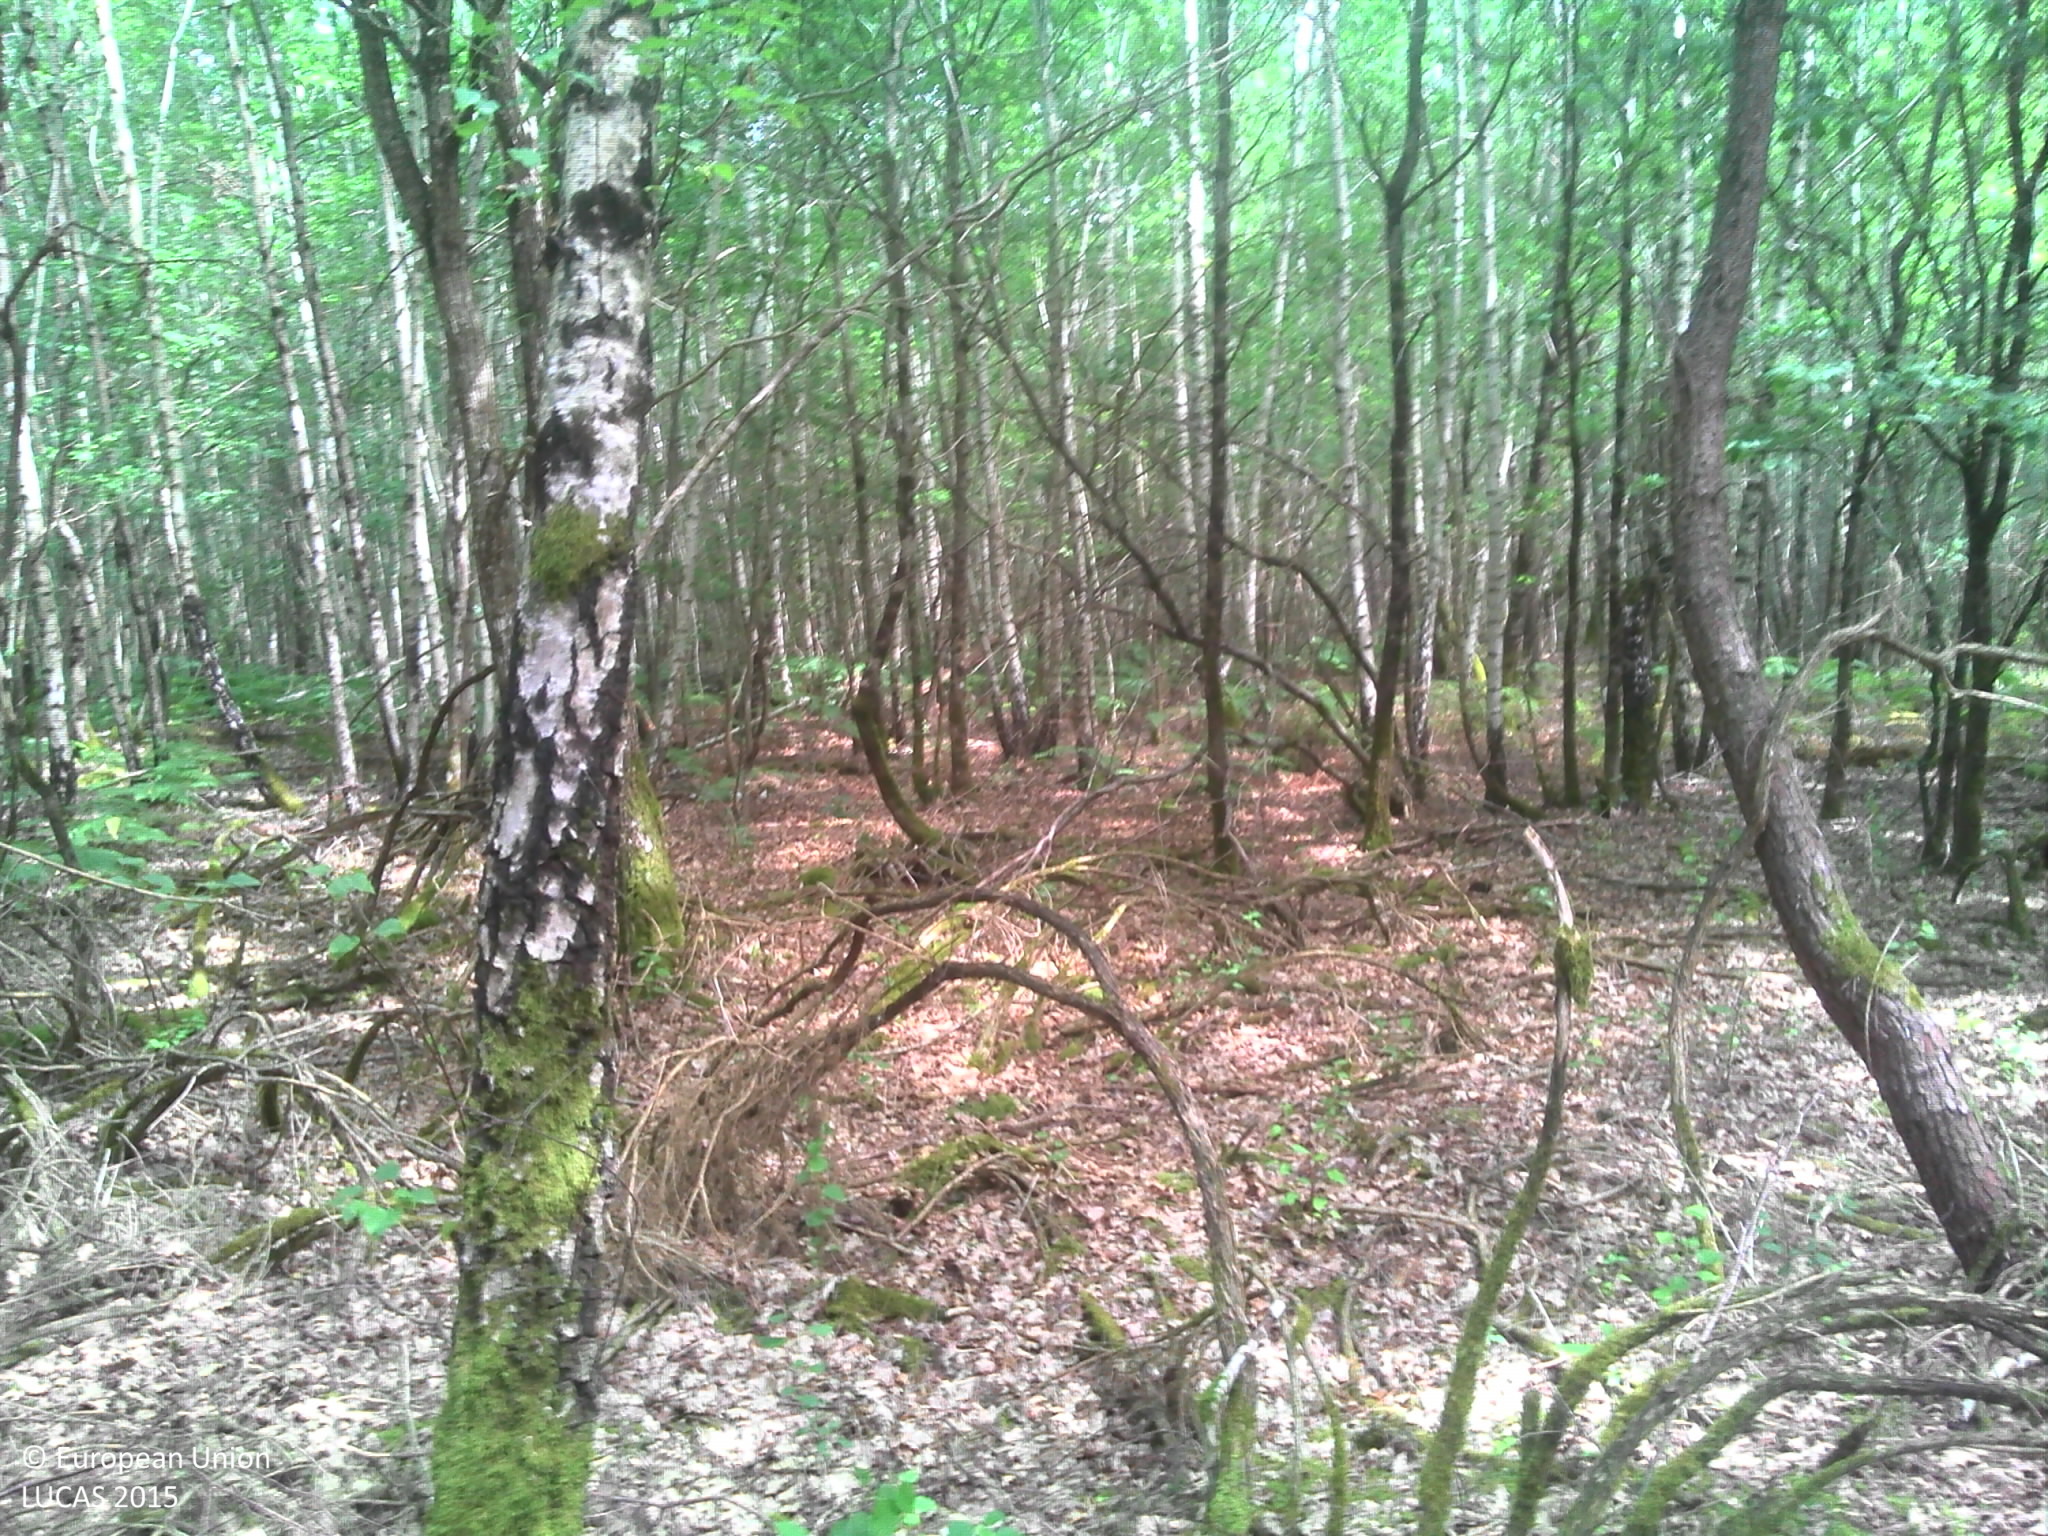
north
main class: Woodland
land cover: Pine dominated mixed woodland
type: thermophilous deciduous forest
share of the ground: > 75 %
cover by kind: unconsolidated bare surface 30 %, herbaceous plants 20 %, lichens and mosses 20 %, coniferous forest trees 15 %, broadleaved forest trees 15 %
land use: Forestry
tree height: > 5 m
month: June
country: FR
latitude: 47.3417
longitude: 1.3694
